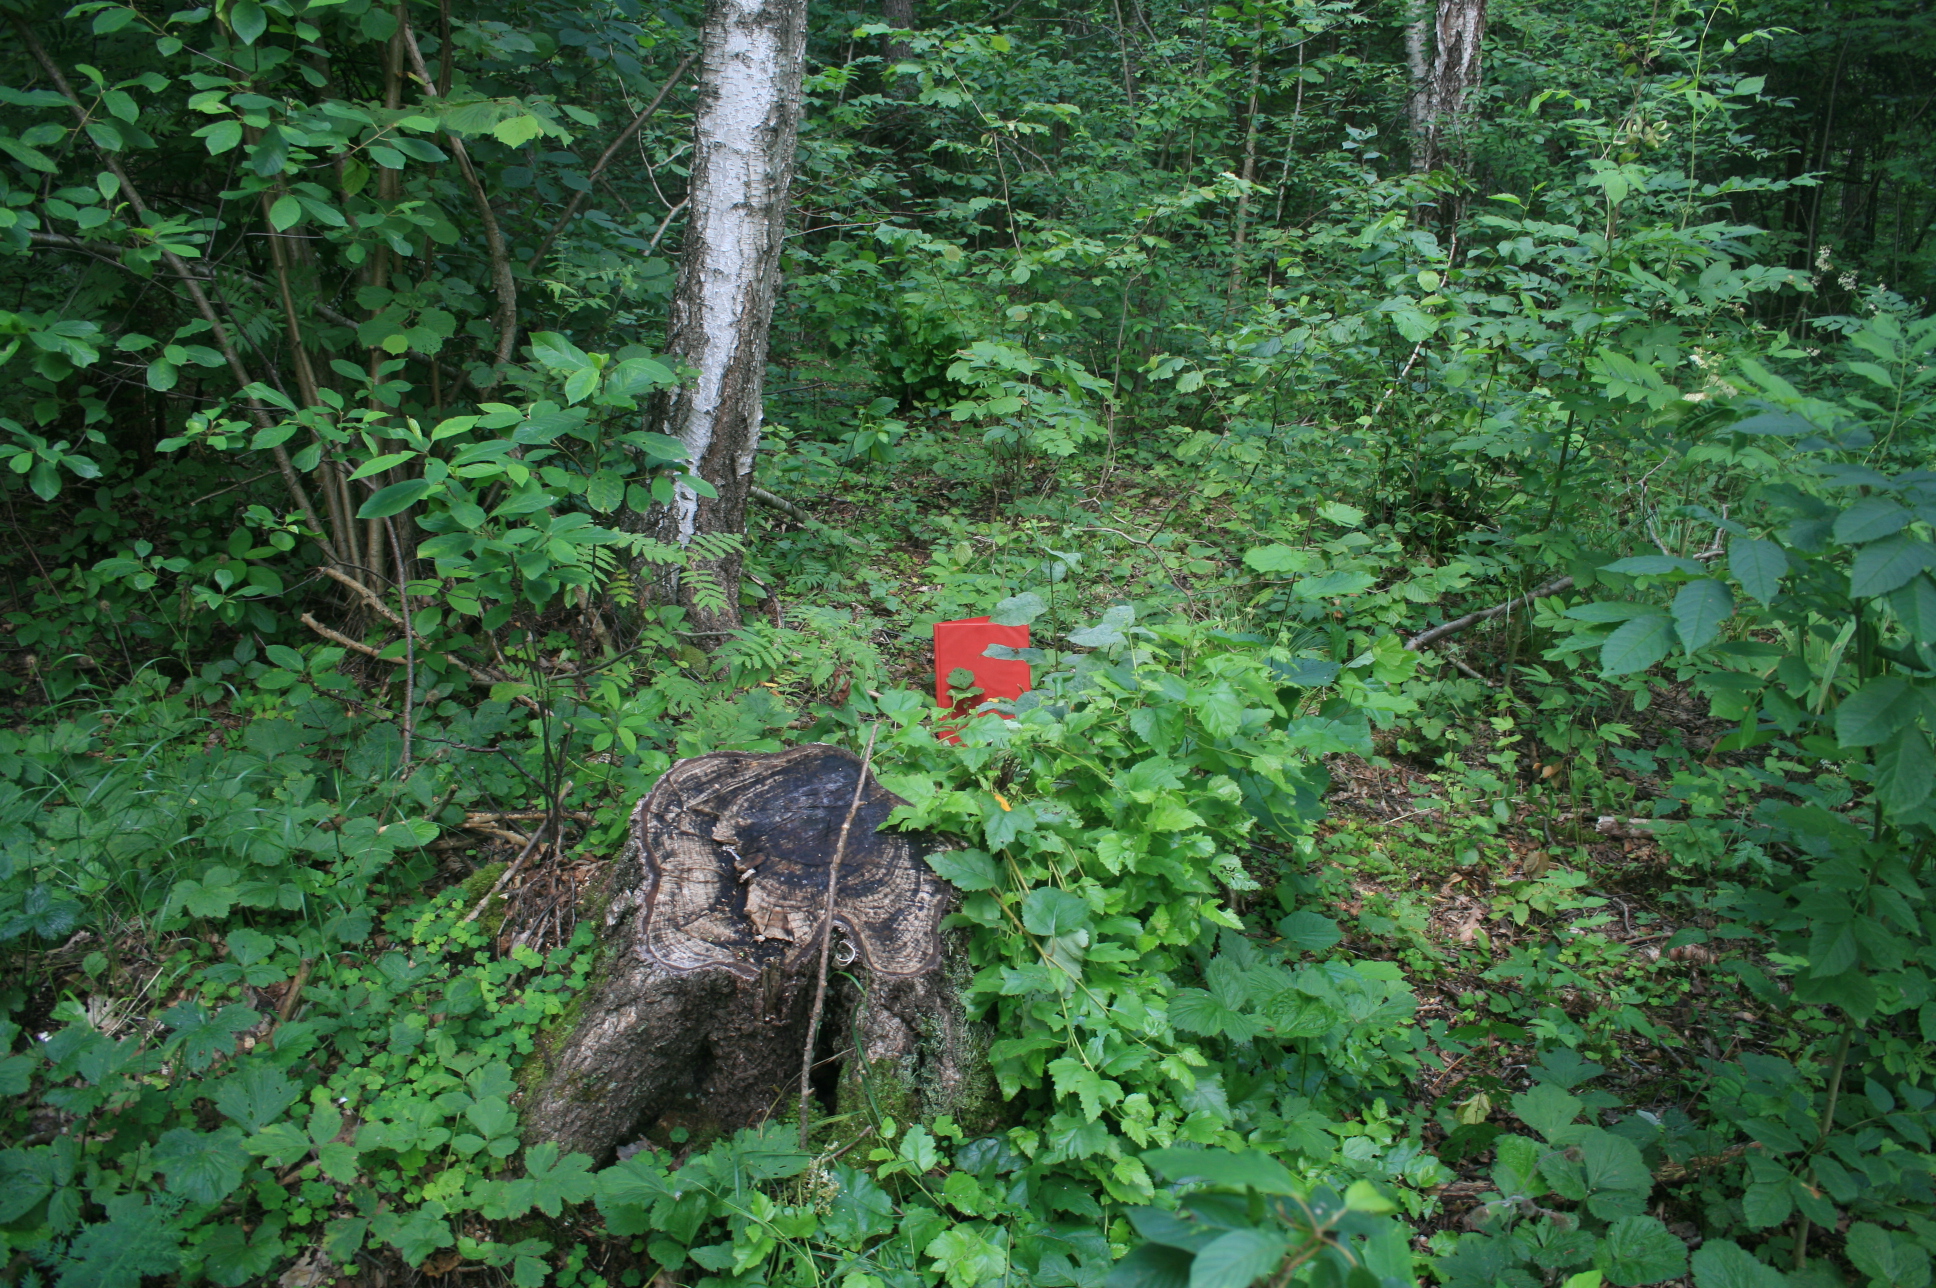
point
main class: Woodland
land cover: Broadleaved woodland
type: non-riverine alder, birch or aspen forest
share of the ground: > 75 %
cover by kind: broadleaved forest trees 90 %, shrubs 5 %, herbaceous plants 5 %
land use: Forestry
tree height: > 5 m
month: July
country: LT
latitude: 55.7857
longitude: 21.4135
